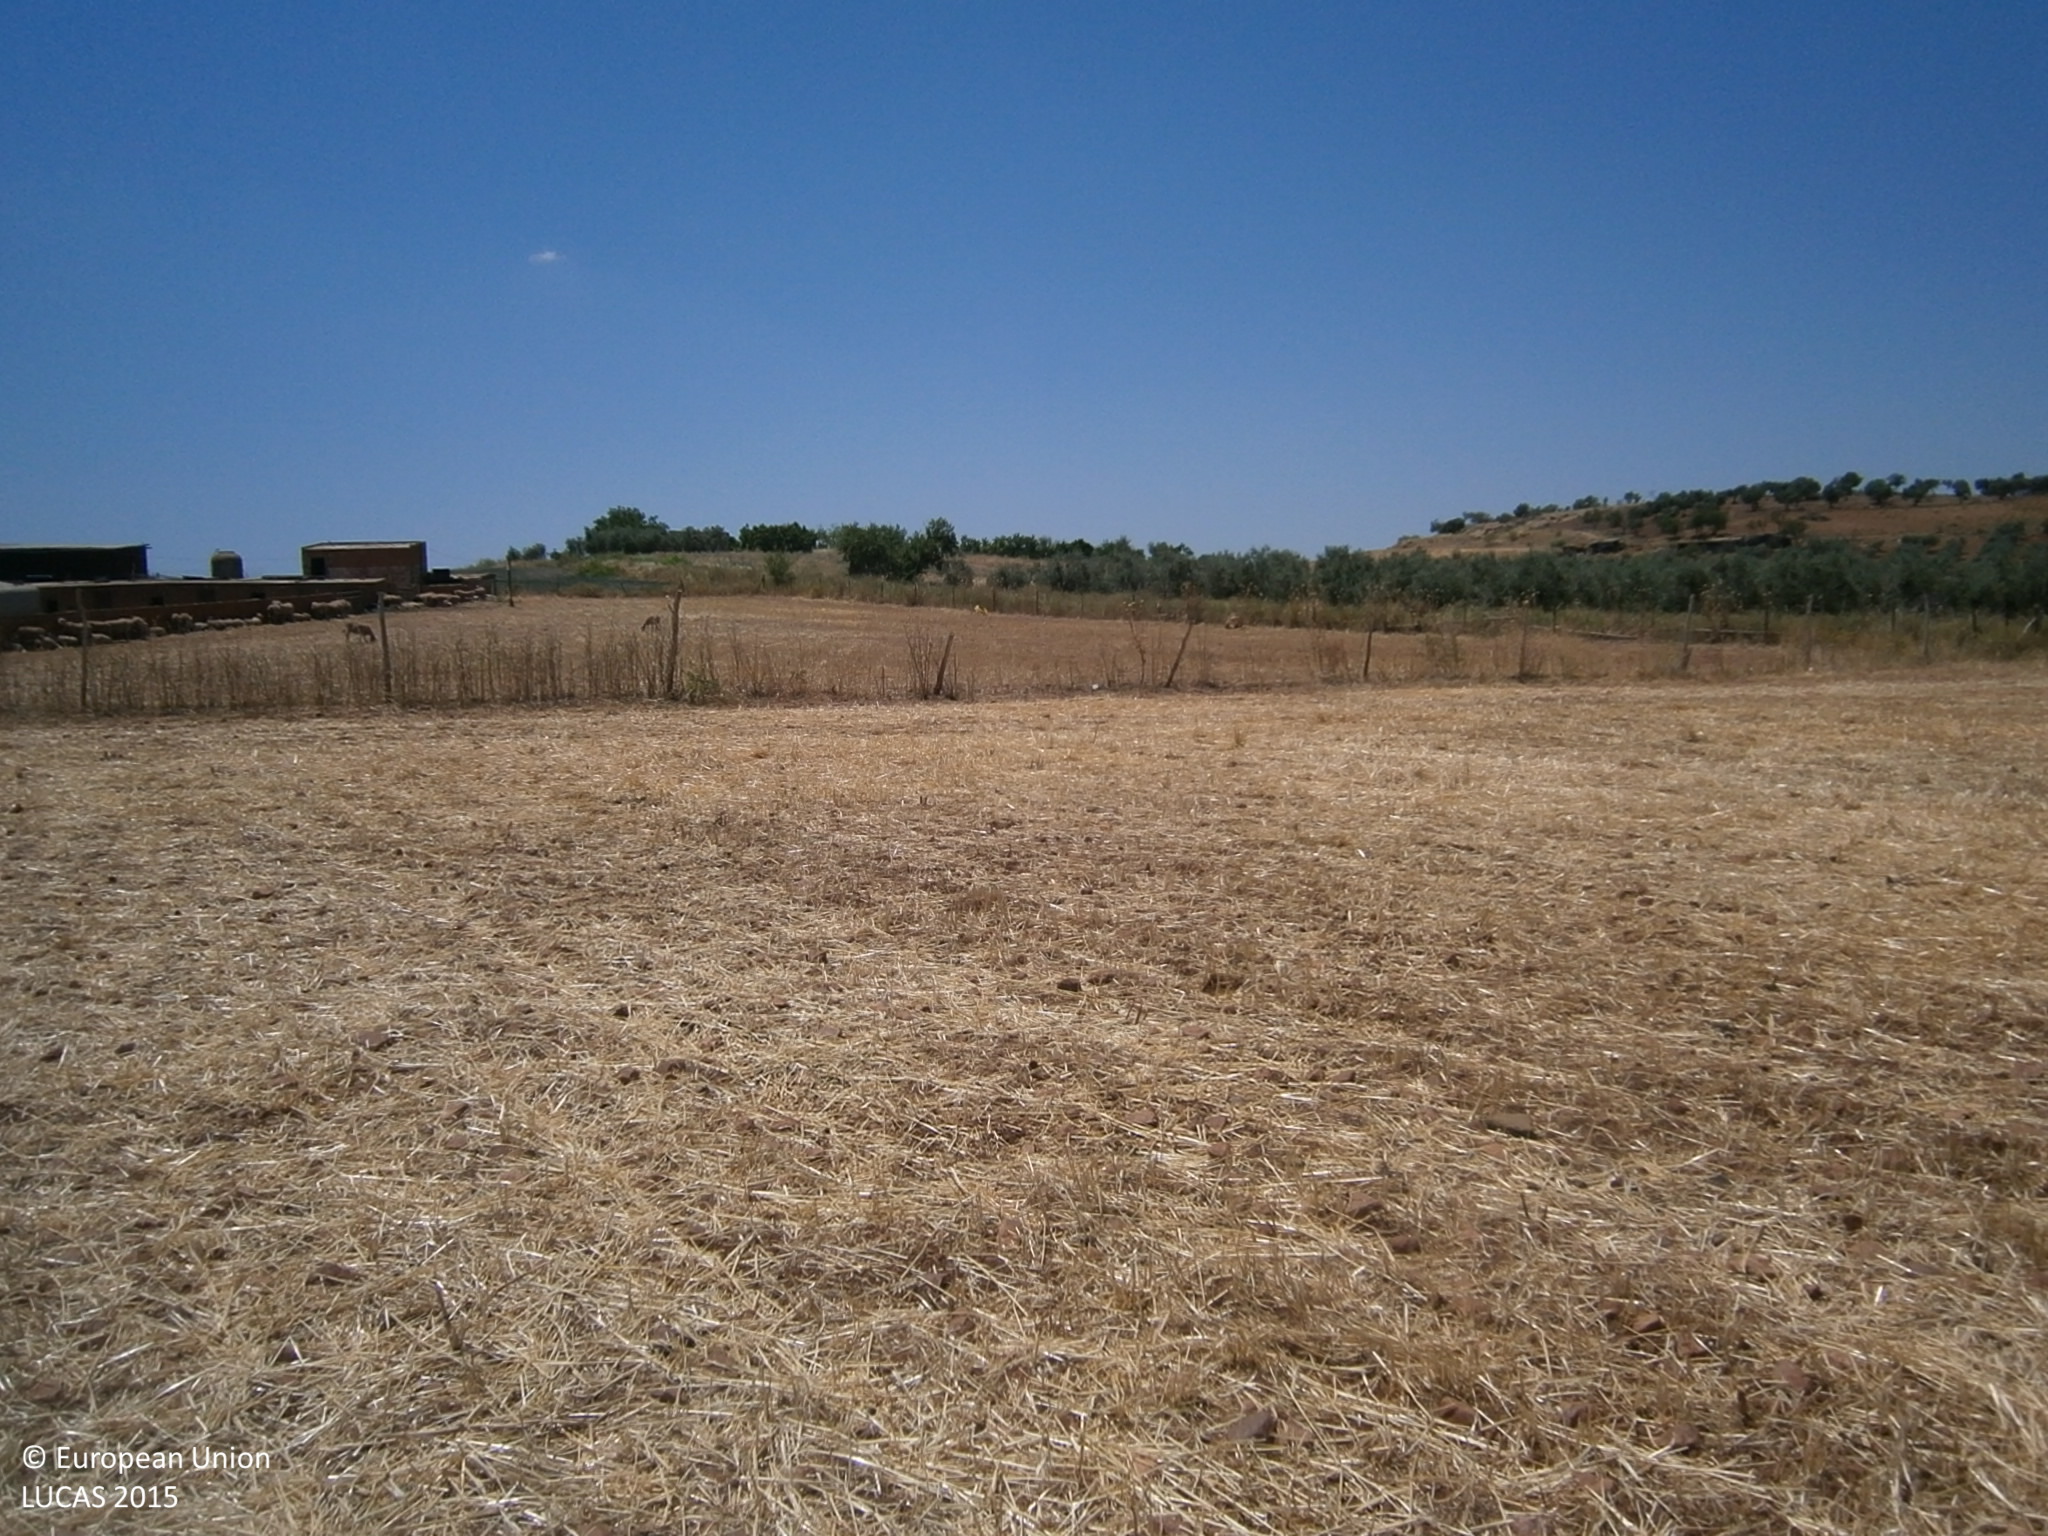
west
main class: Cropland
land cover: Temporary grasslands
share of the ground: > 75 %
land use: Agriculture (excluding fallow land and kitchen gardens)
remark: Harvested field
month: June
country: ES
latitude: 38.8129
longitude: -6.2343
